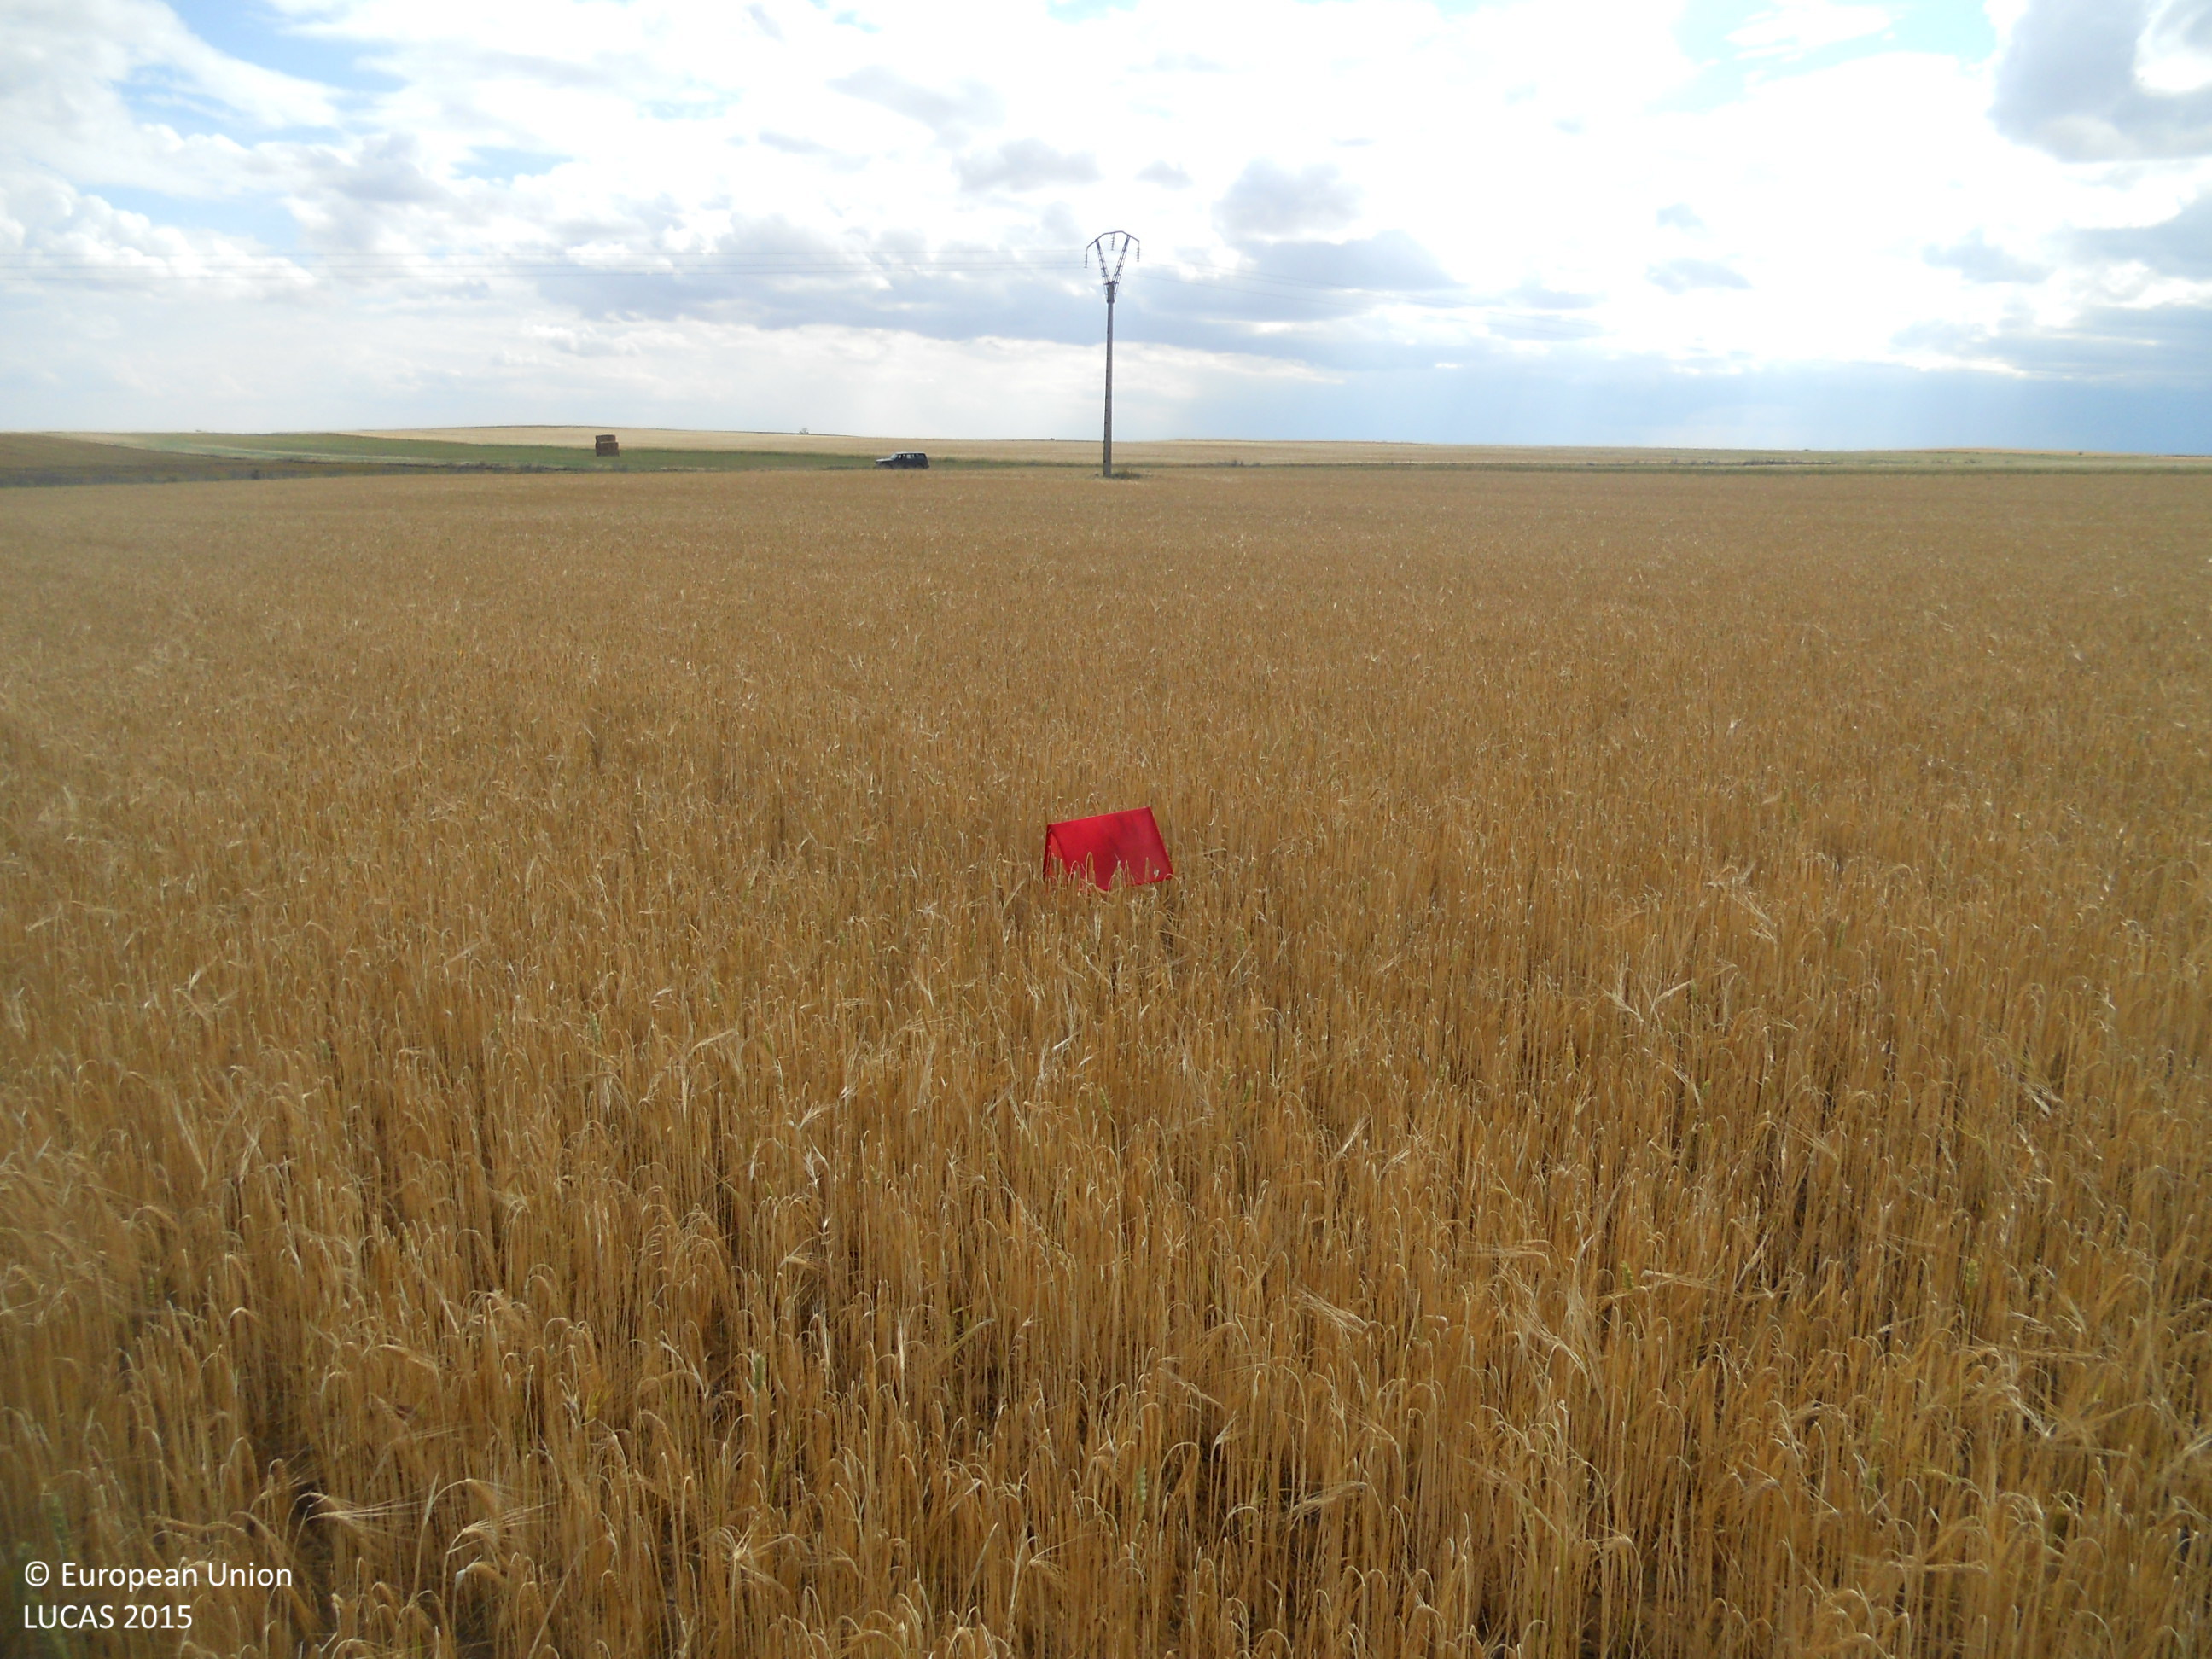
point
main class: Cropland
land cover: Barley
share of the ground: > 75 %
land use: Agriculture (excluding fallow land and kitchen gardens)
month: June
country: ES
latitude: 42.3545
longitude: -4.8797
